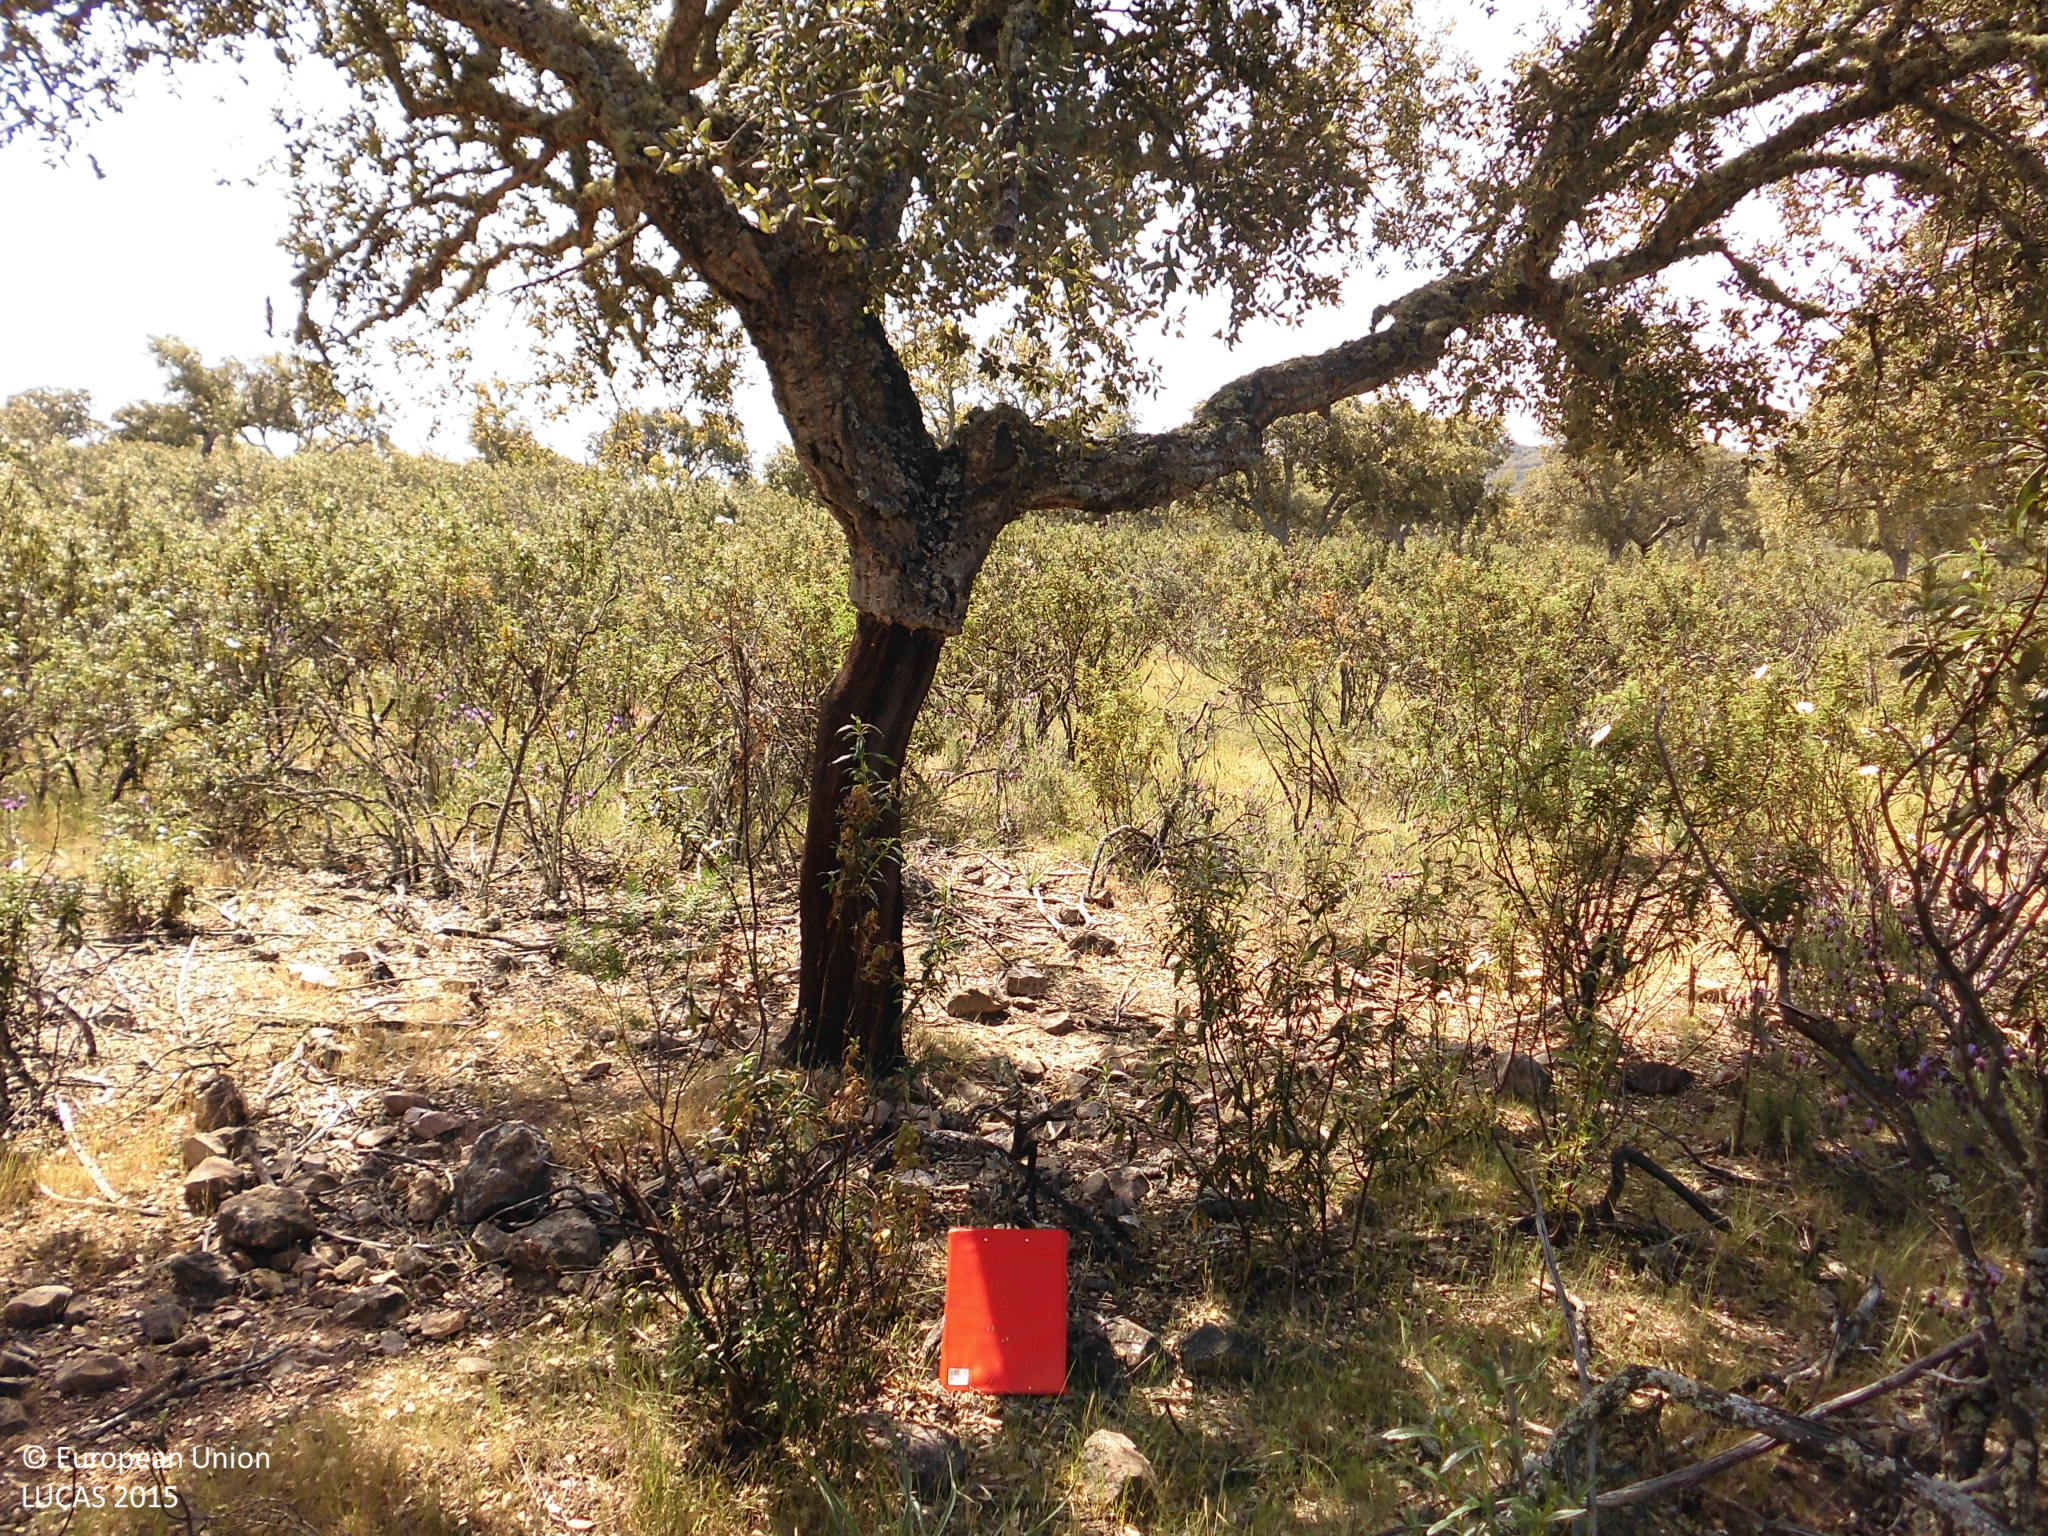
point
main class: Woodland
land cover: Broadleaved woodland
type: broadleaved evergreen forest
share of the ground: 10 - 25 %
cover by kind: herbaceous plants 55 %, shrubs 30 %, broadleaved forest trees 15 %
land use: Forestry
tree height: > 5 m
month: May
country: ES
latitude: 39.4705
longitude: -7.1130
